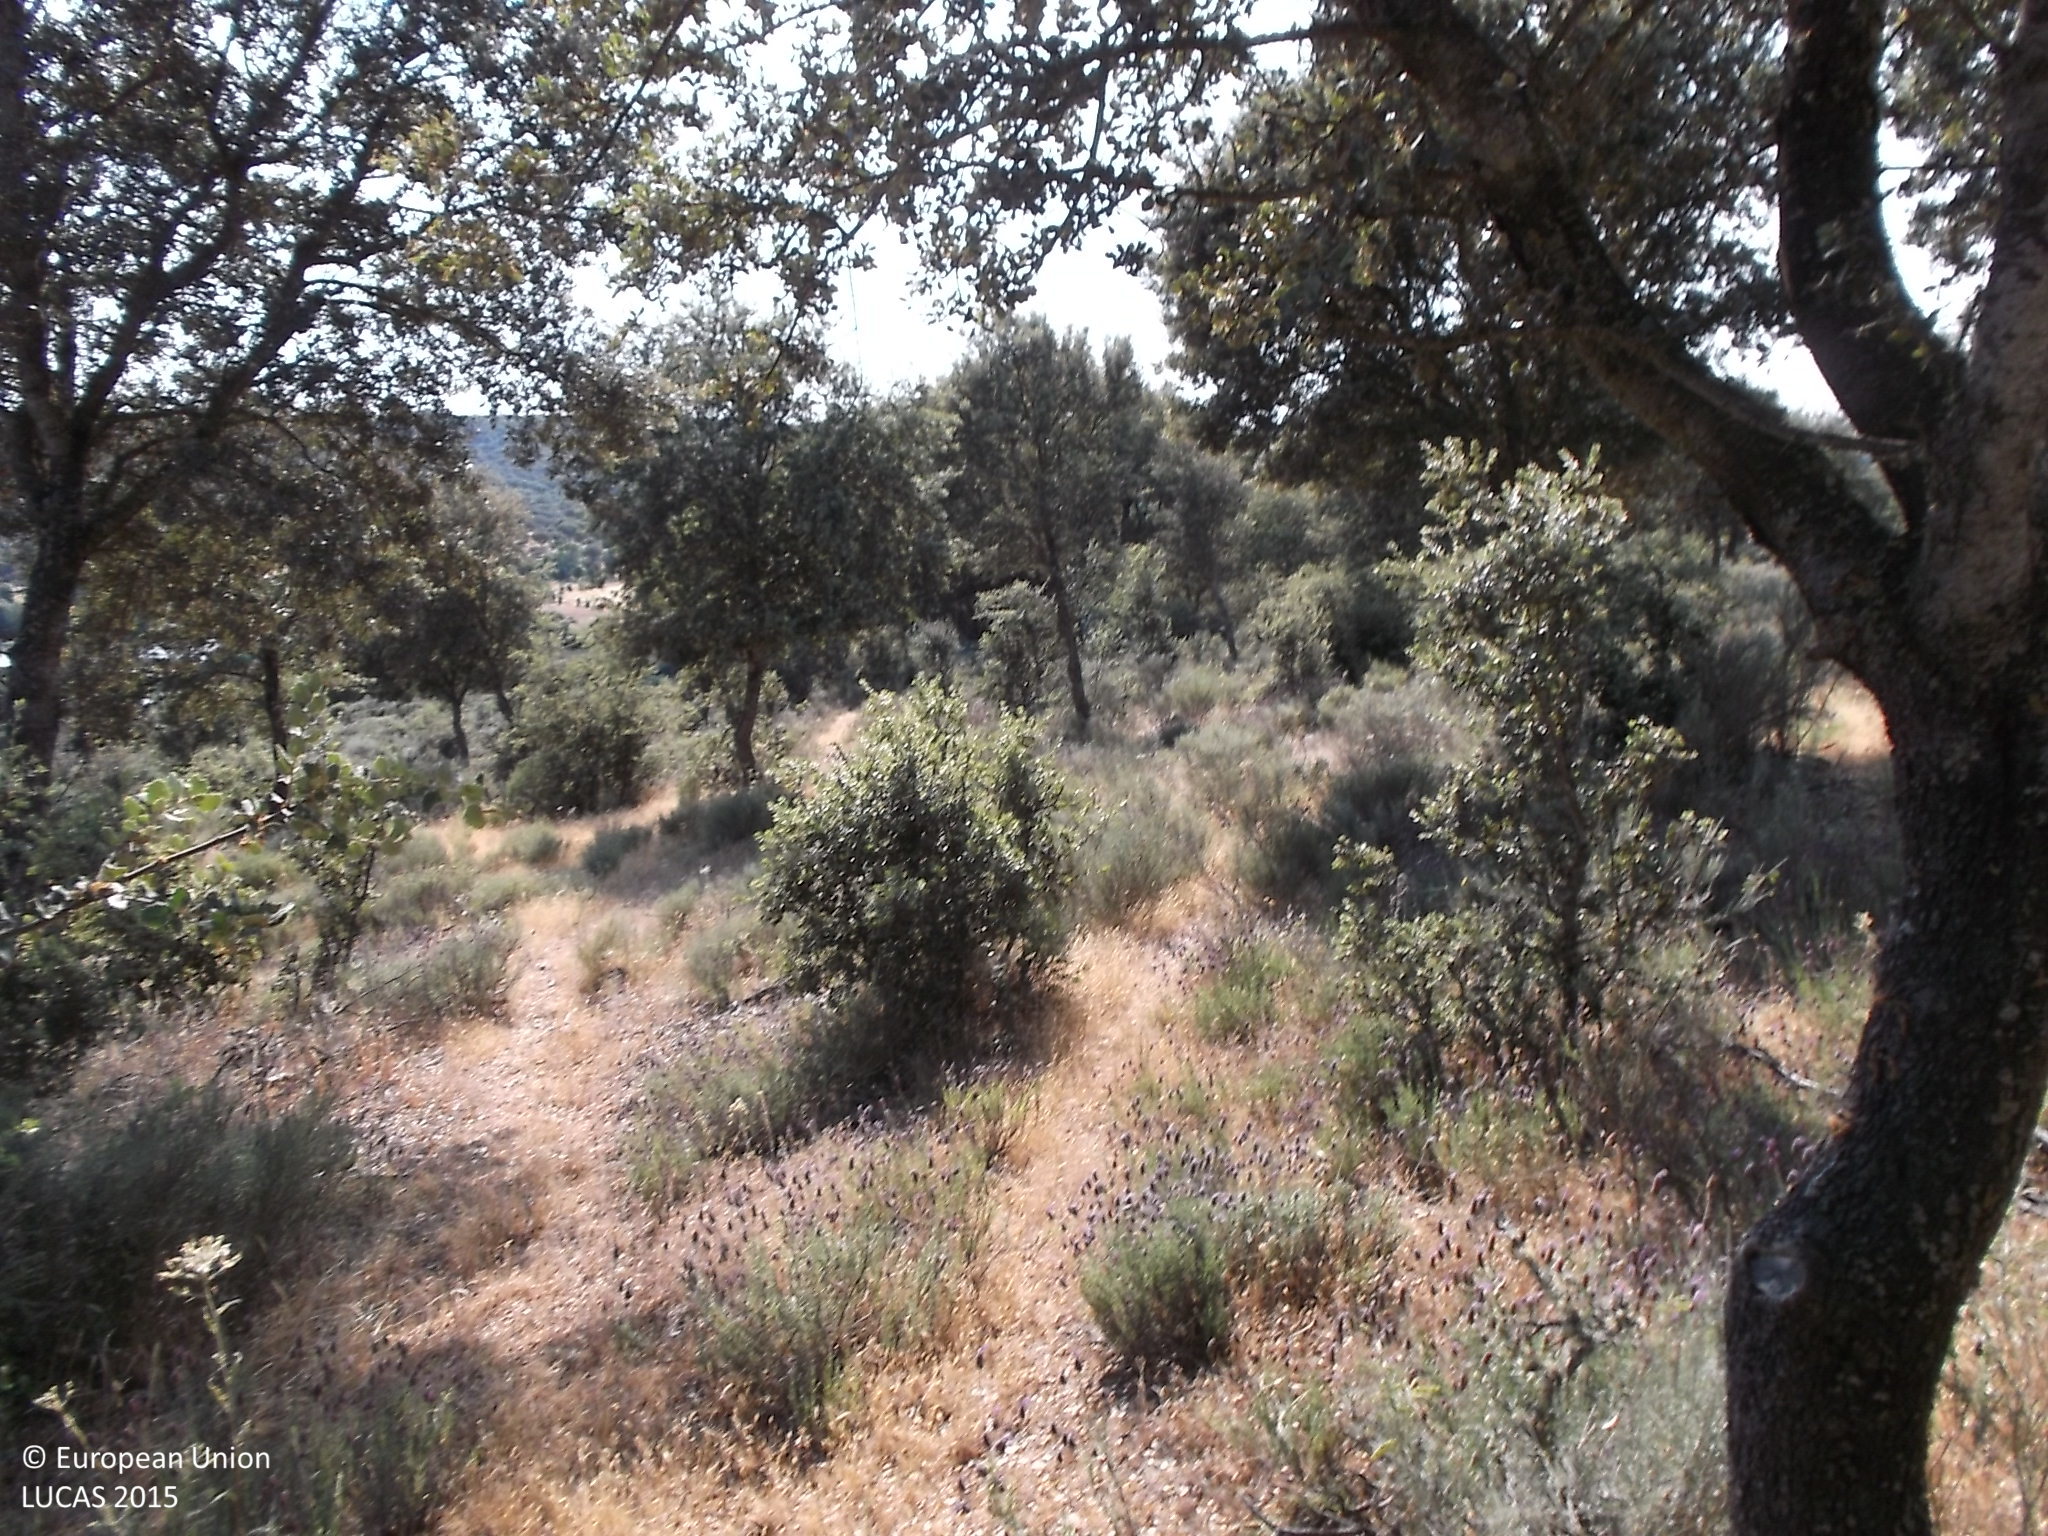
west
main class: Woodland
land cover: Broadleaved woodland
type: thermophilous deciduous forest
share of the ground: 10 - 25 %
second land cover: Shrubland without tree cover
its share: 50 - 75 %
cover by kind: shrubs 50 %, herbaceous plants 35 %, broadleaved forest trees 15 %
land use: Forestry
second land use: Agriculture (excluding fallow land and kitchen gardens)
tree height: > 5 m
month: June
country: ES
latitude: 40.8604
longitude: -6.4276
